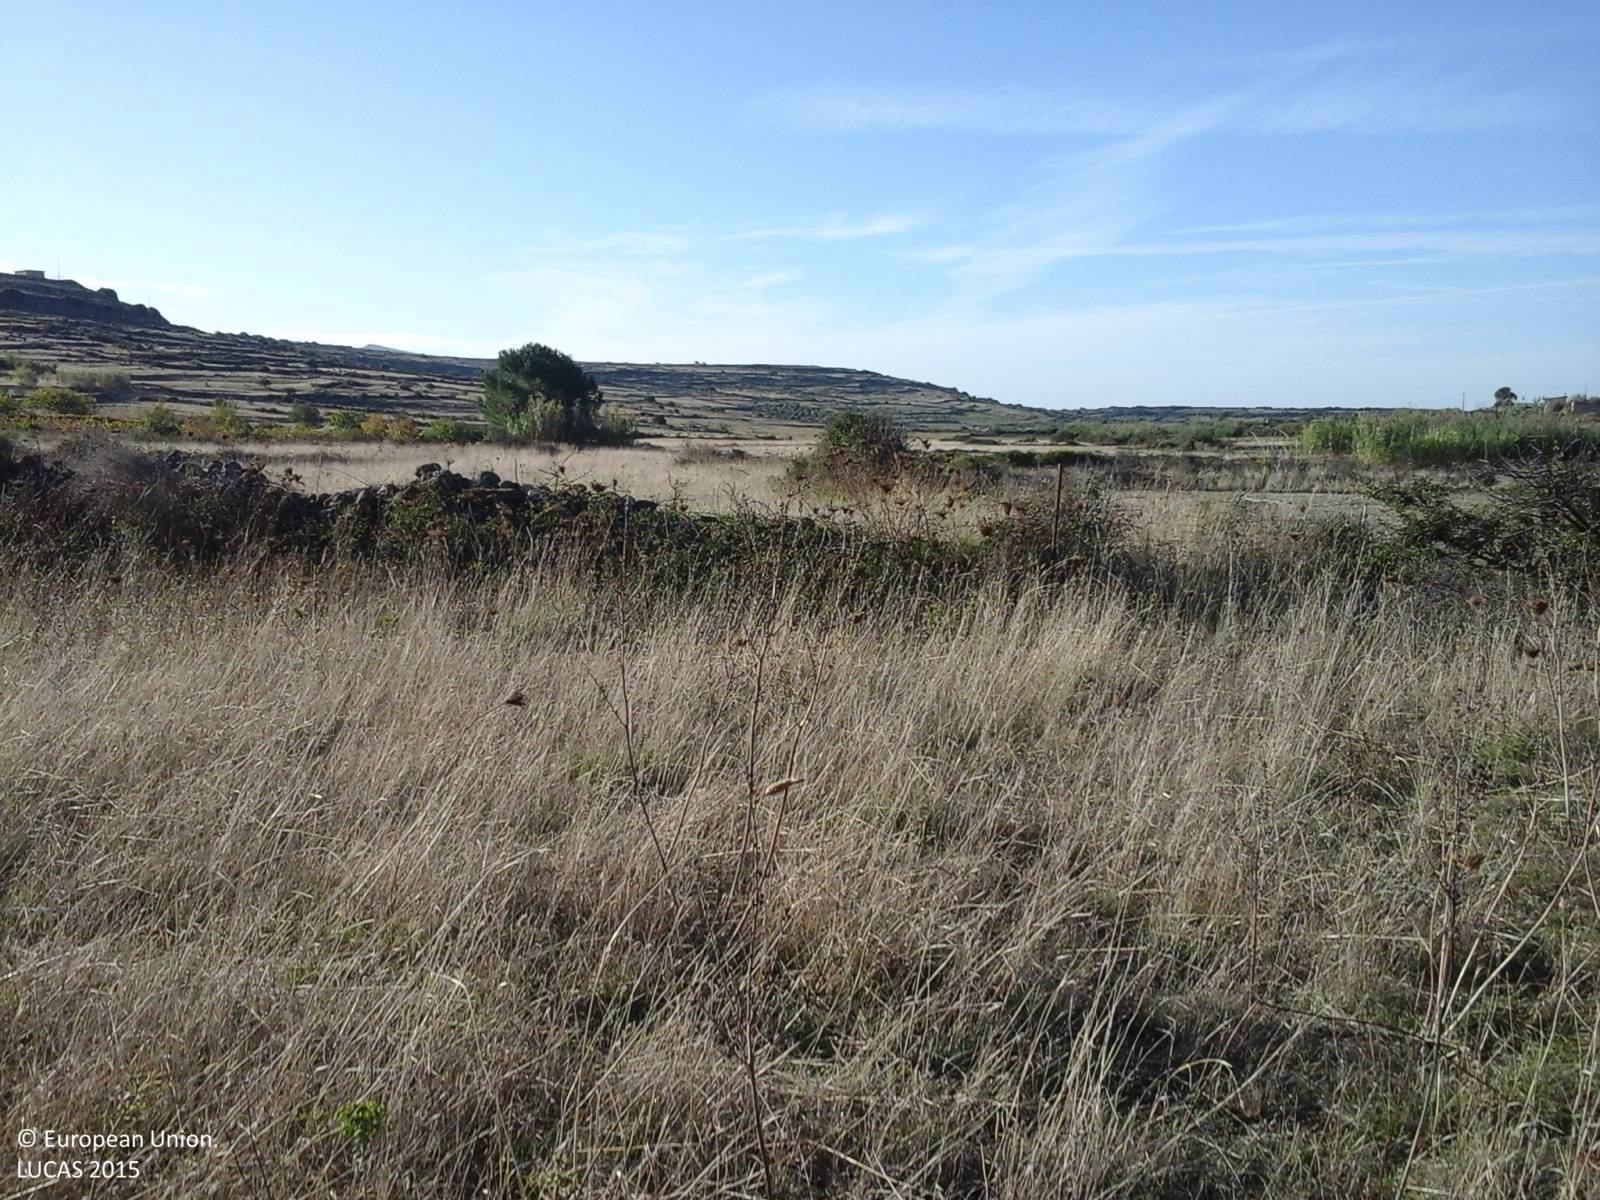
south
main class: Grassland
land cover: Grassland without tree/shrub cover
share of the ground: > 75 %
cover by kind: herbaceous plants 100 %
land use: Agriculture (excluding fallow land and kitchen gardens)
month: October
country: IT
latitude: 40.2564
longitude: 8.5380
